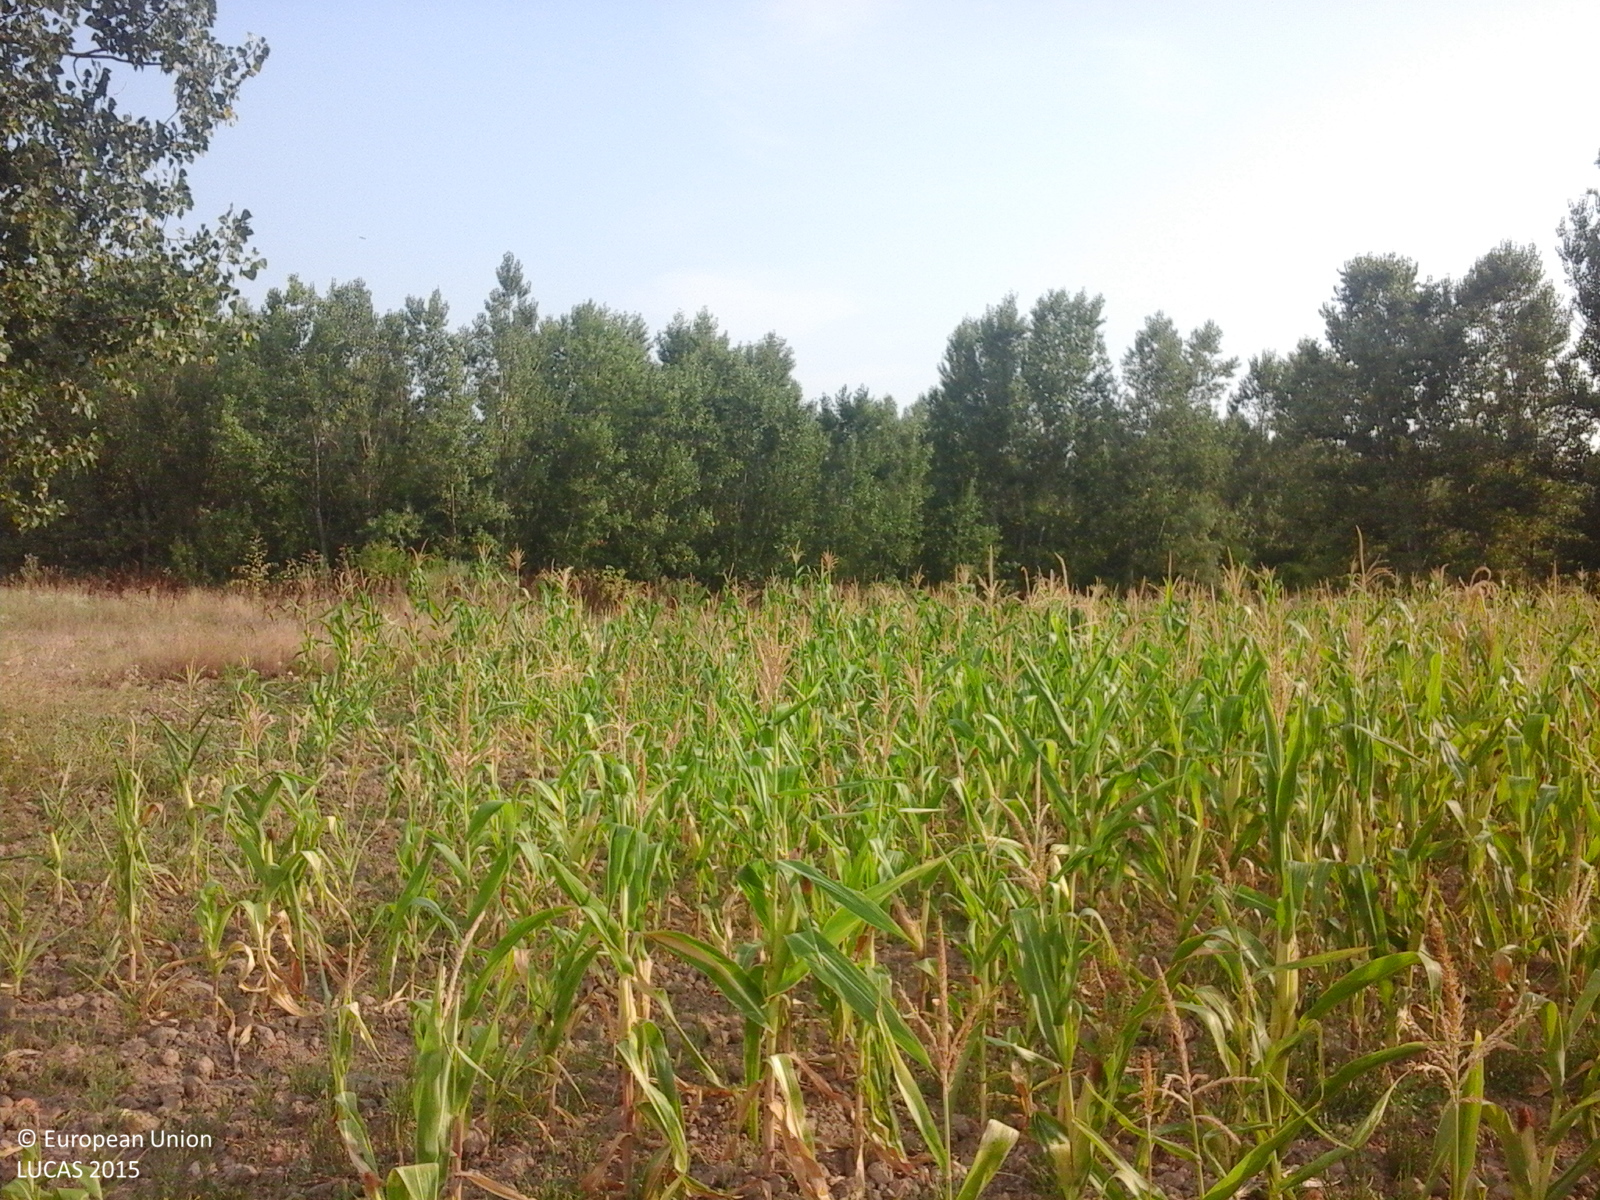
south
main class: Cropland
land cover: Maize
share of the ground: > 75 %
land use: Agriculture (excluding fallow land and kitchen gardens)
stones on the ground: < 10 %
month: August
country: RO
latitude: 44.6865
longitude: 23.6461
